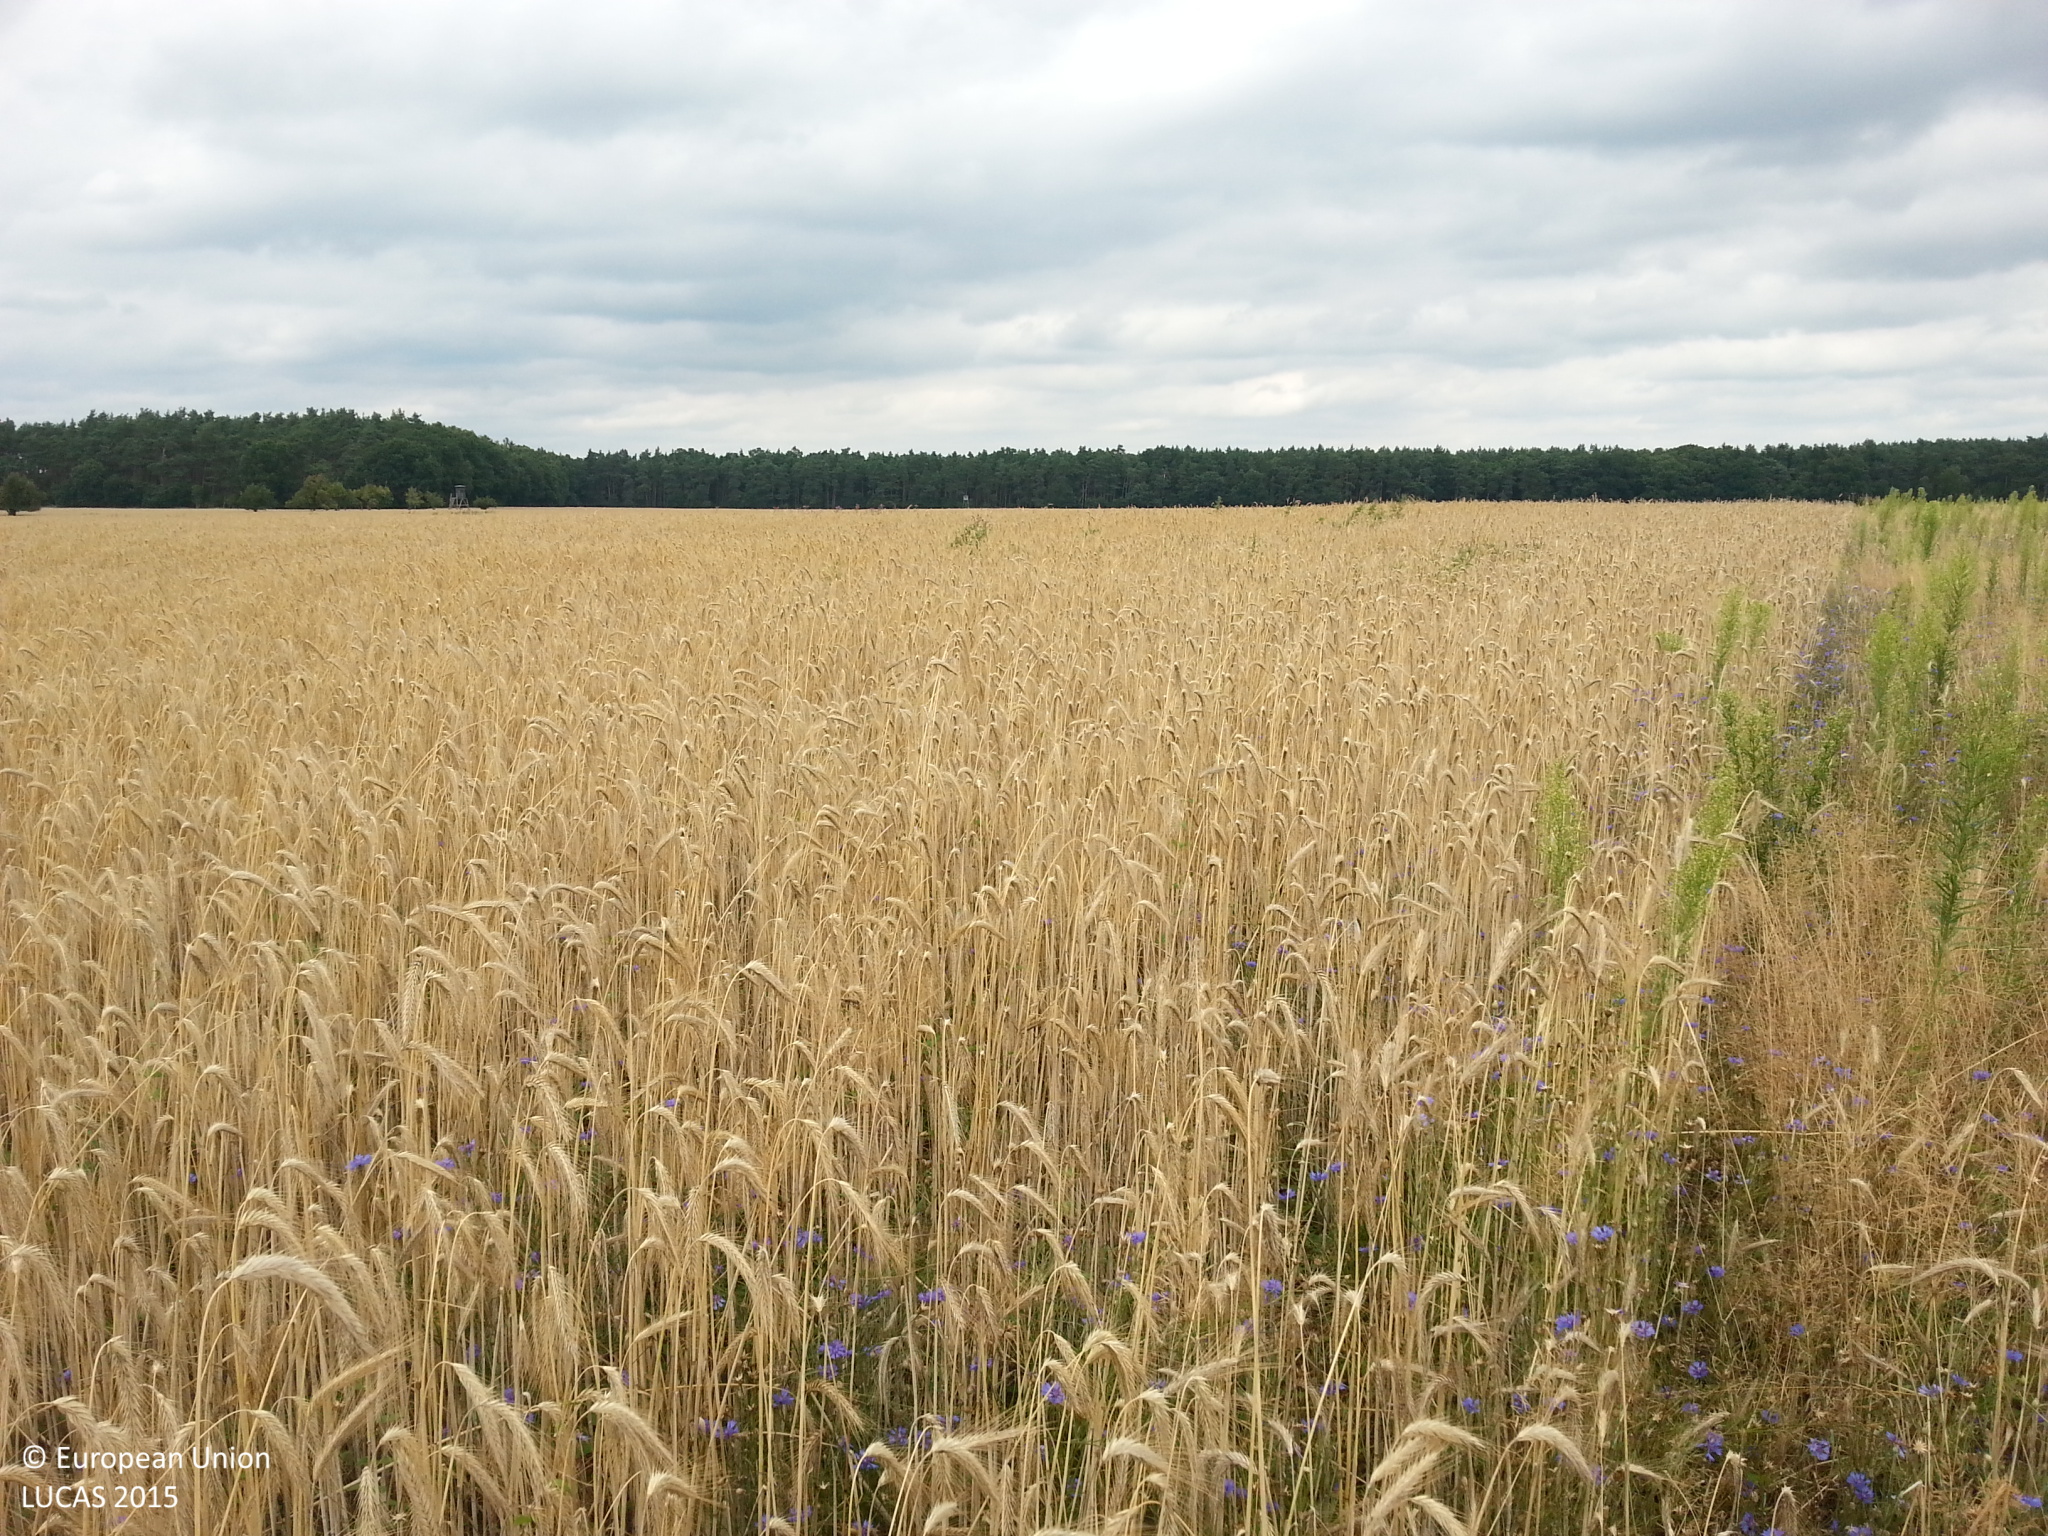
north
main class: Cropland
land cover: Rye
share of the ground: > 75 %
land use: Agriculture (excluding fallow land and kitchen gardens)
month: July
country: DE
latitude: 53.2874
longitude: 12.4444
